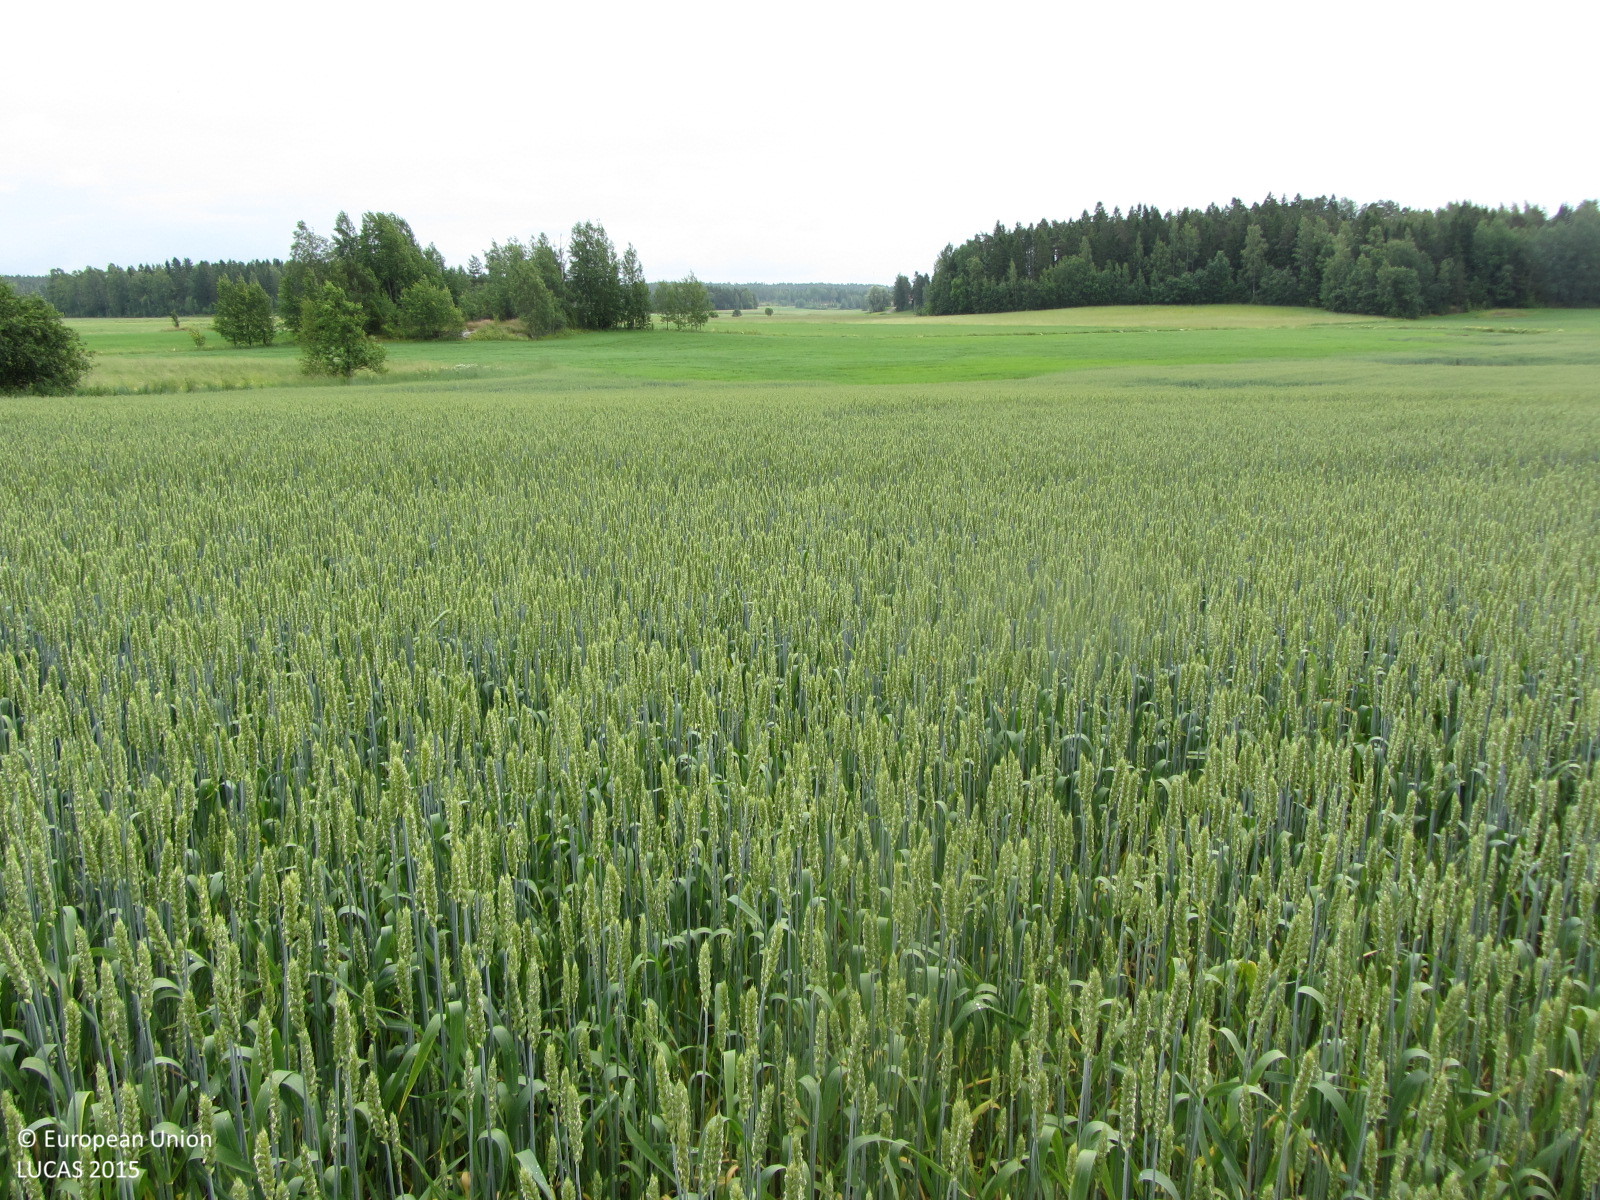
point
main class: Cropland
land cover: Common wheat
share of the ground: > 75 %
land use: Agriculture (excluding fallow land and kitchen gardens)
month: July
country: FI
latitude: 60.0583
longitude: 24.0566
